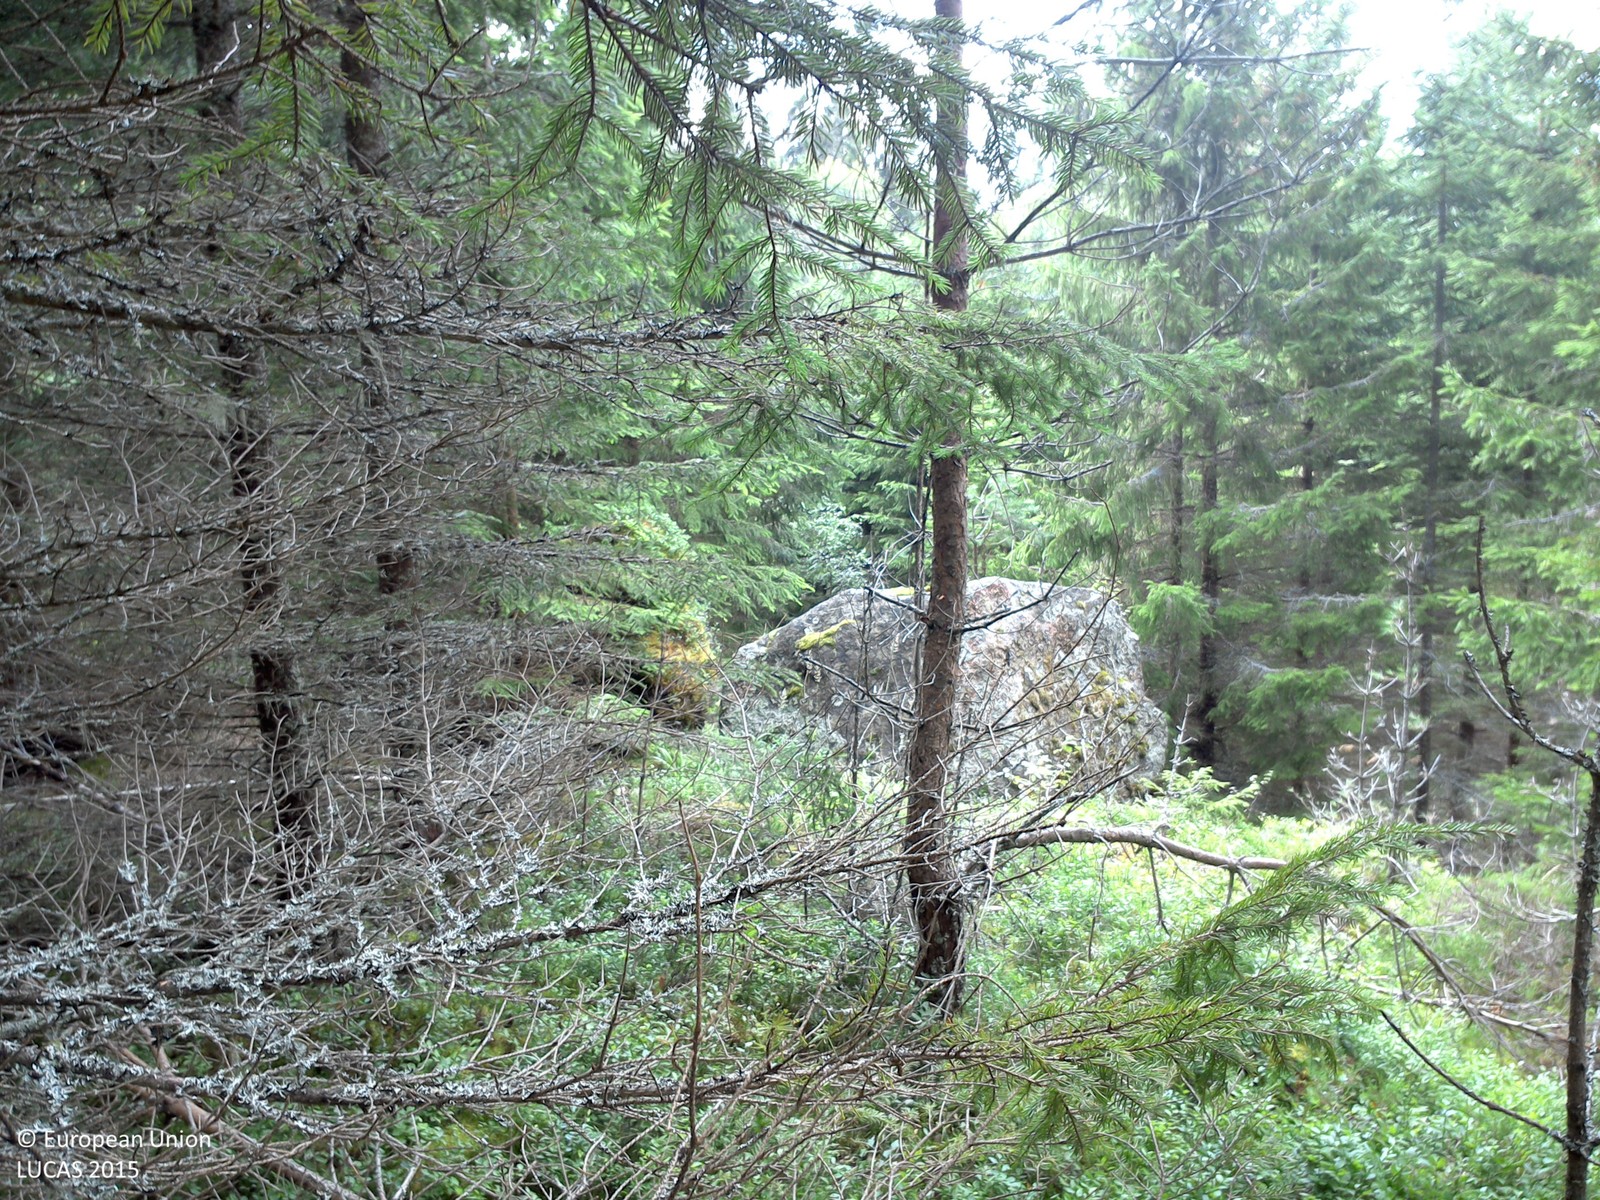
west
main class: Woodland
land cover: Spruce dominated coniferous woodland
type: boreal forest
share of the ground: 50 - 75 %
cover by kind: coniferous forest trees 60 %, lichens and mosses 30 %, herbaceous plants 10 %
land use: Forestry
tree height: > 5 m
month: August
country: SE
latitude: 58.1286
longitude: 15.4117
